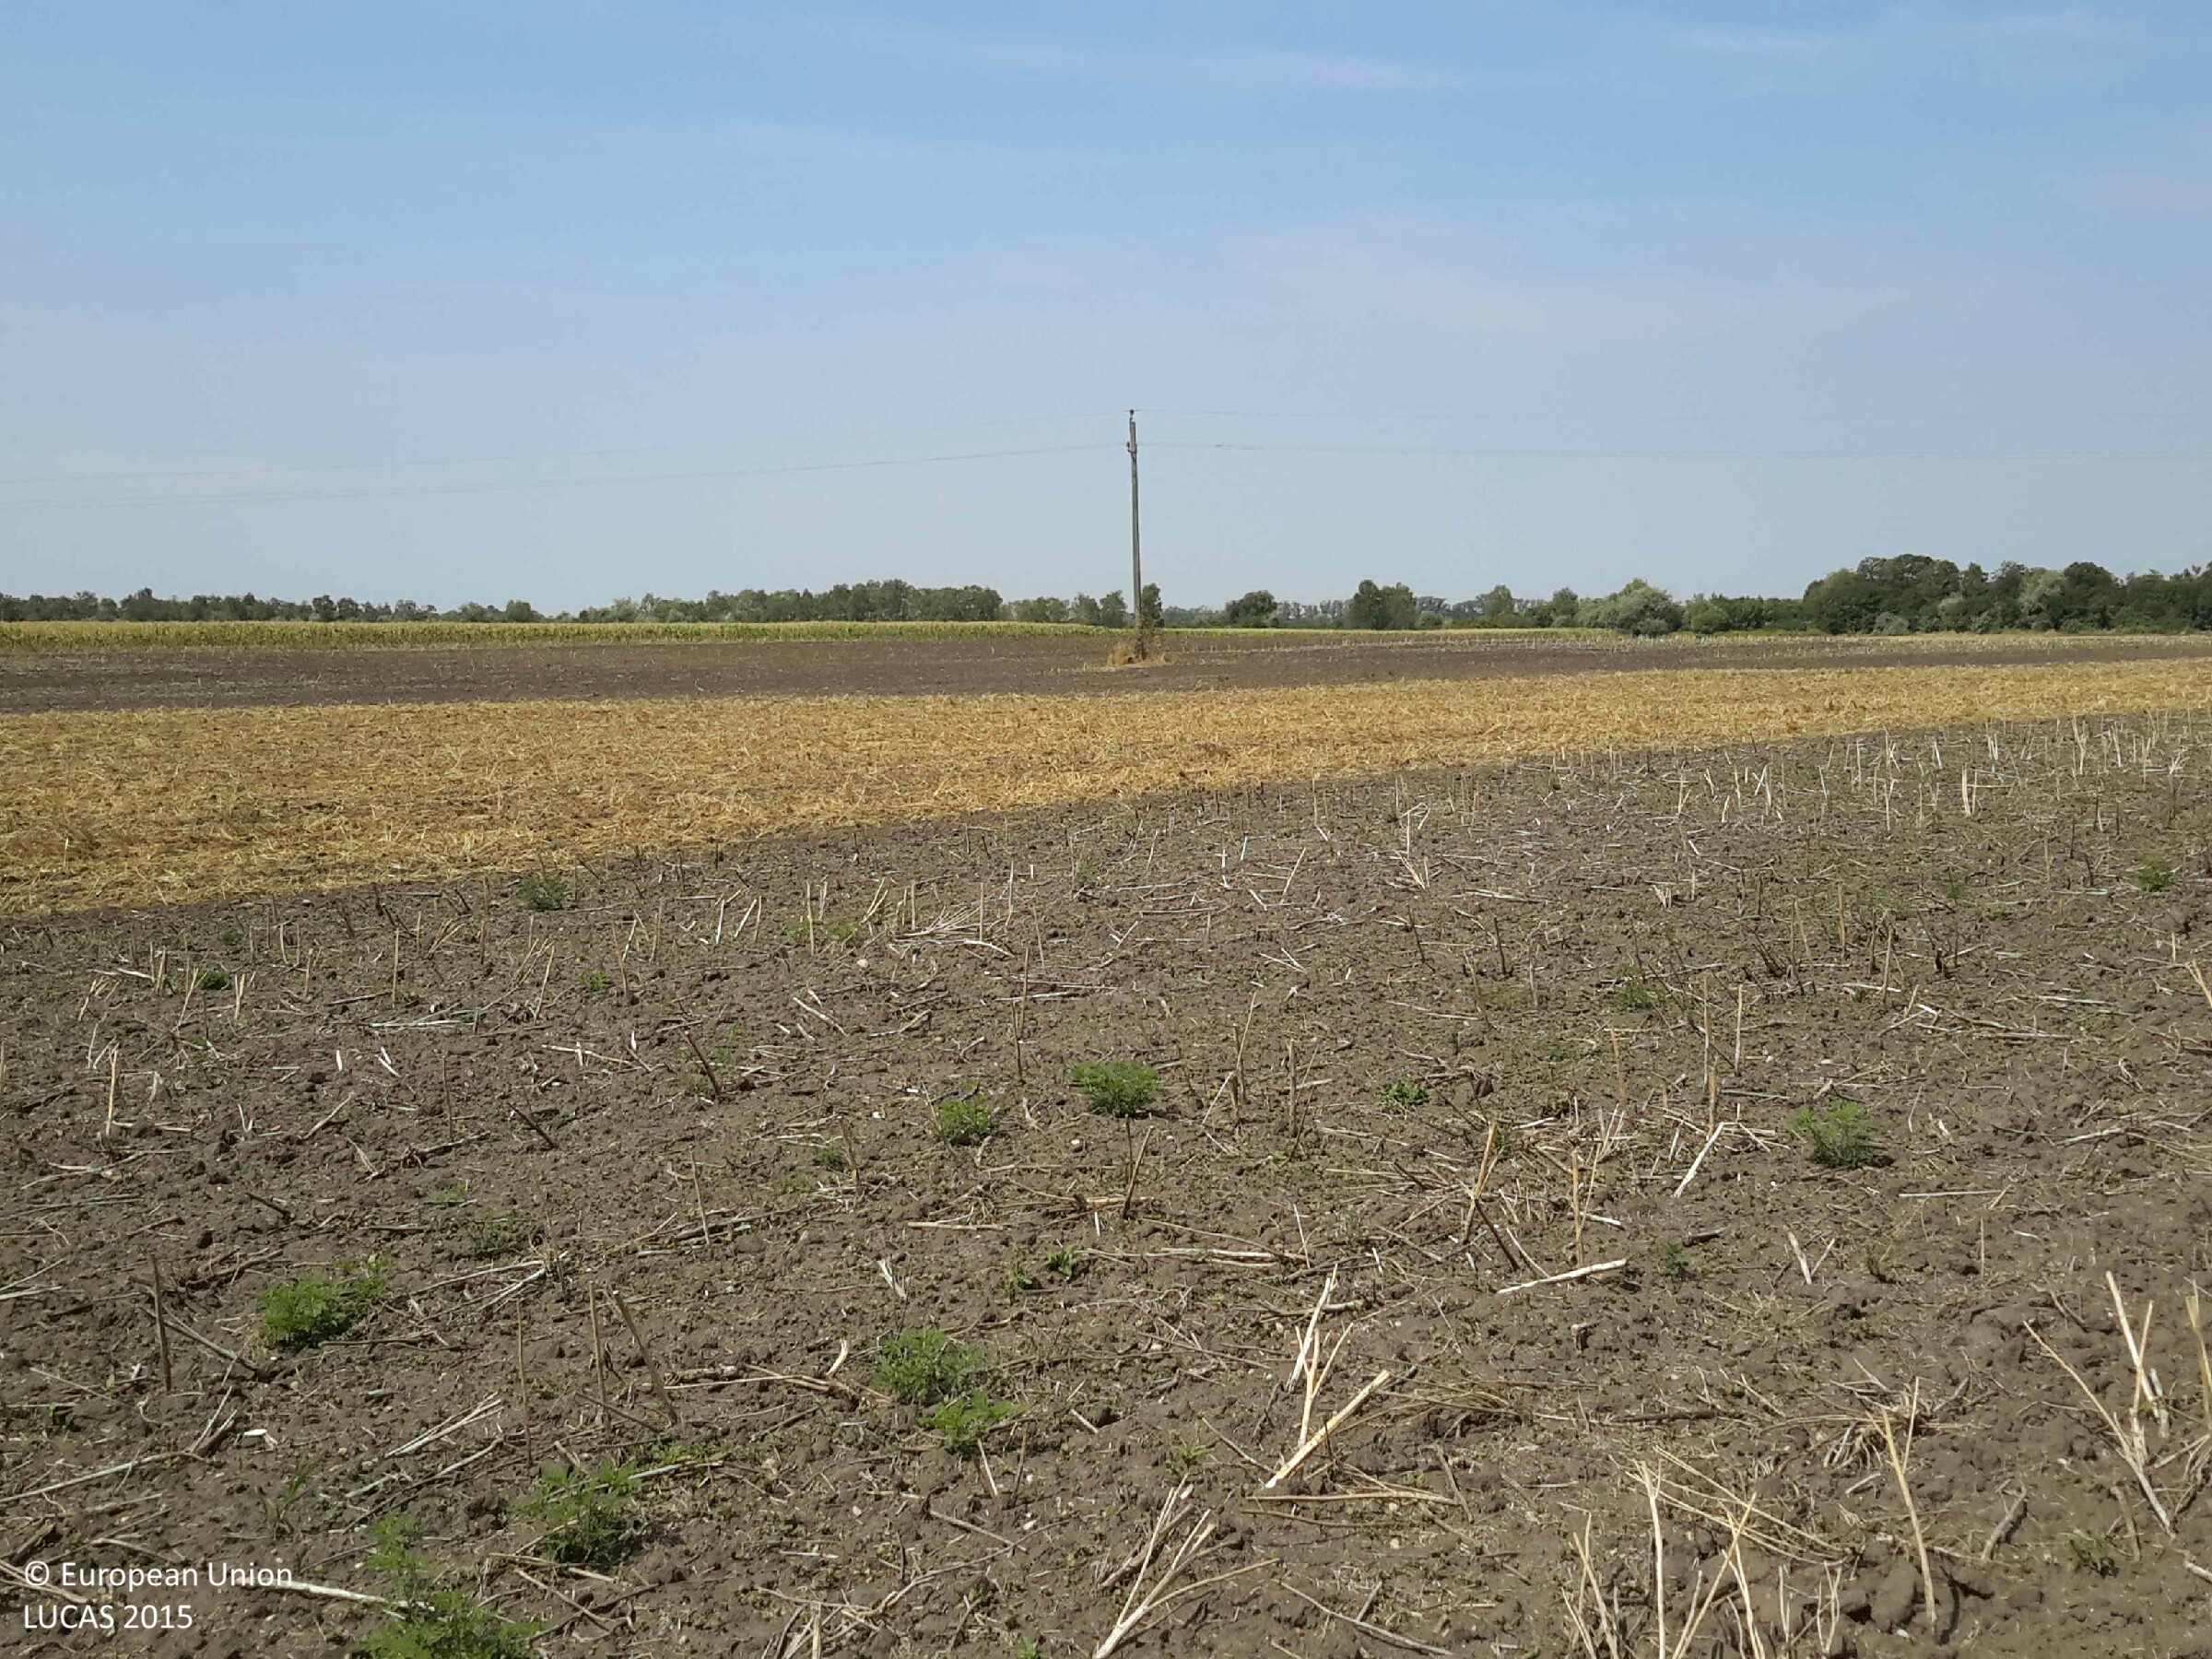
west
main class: Cropland
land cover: Rape and turnip rape
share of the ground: < 10 %
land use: Agriculture (excluding fallow land and kitchen gardens)
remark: Harvested field
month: August
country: HU
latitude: 47.7585
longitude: 17.1175
